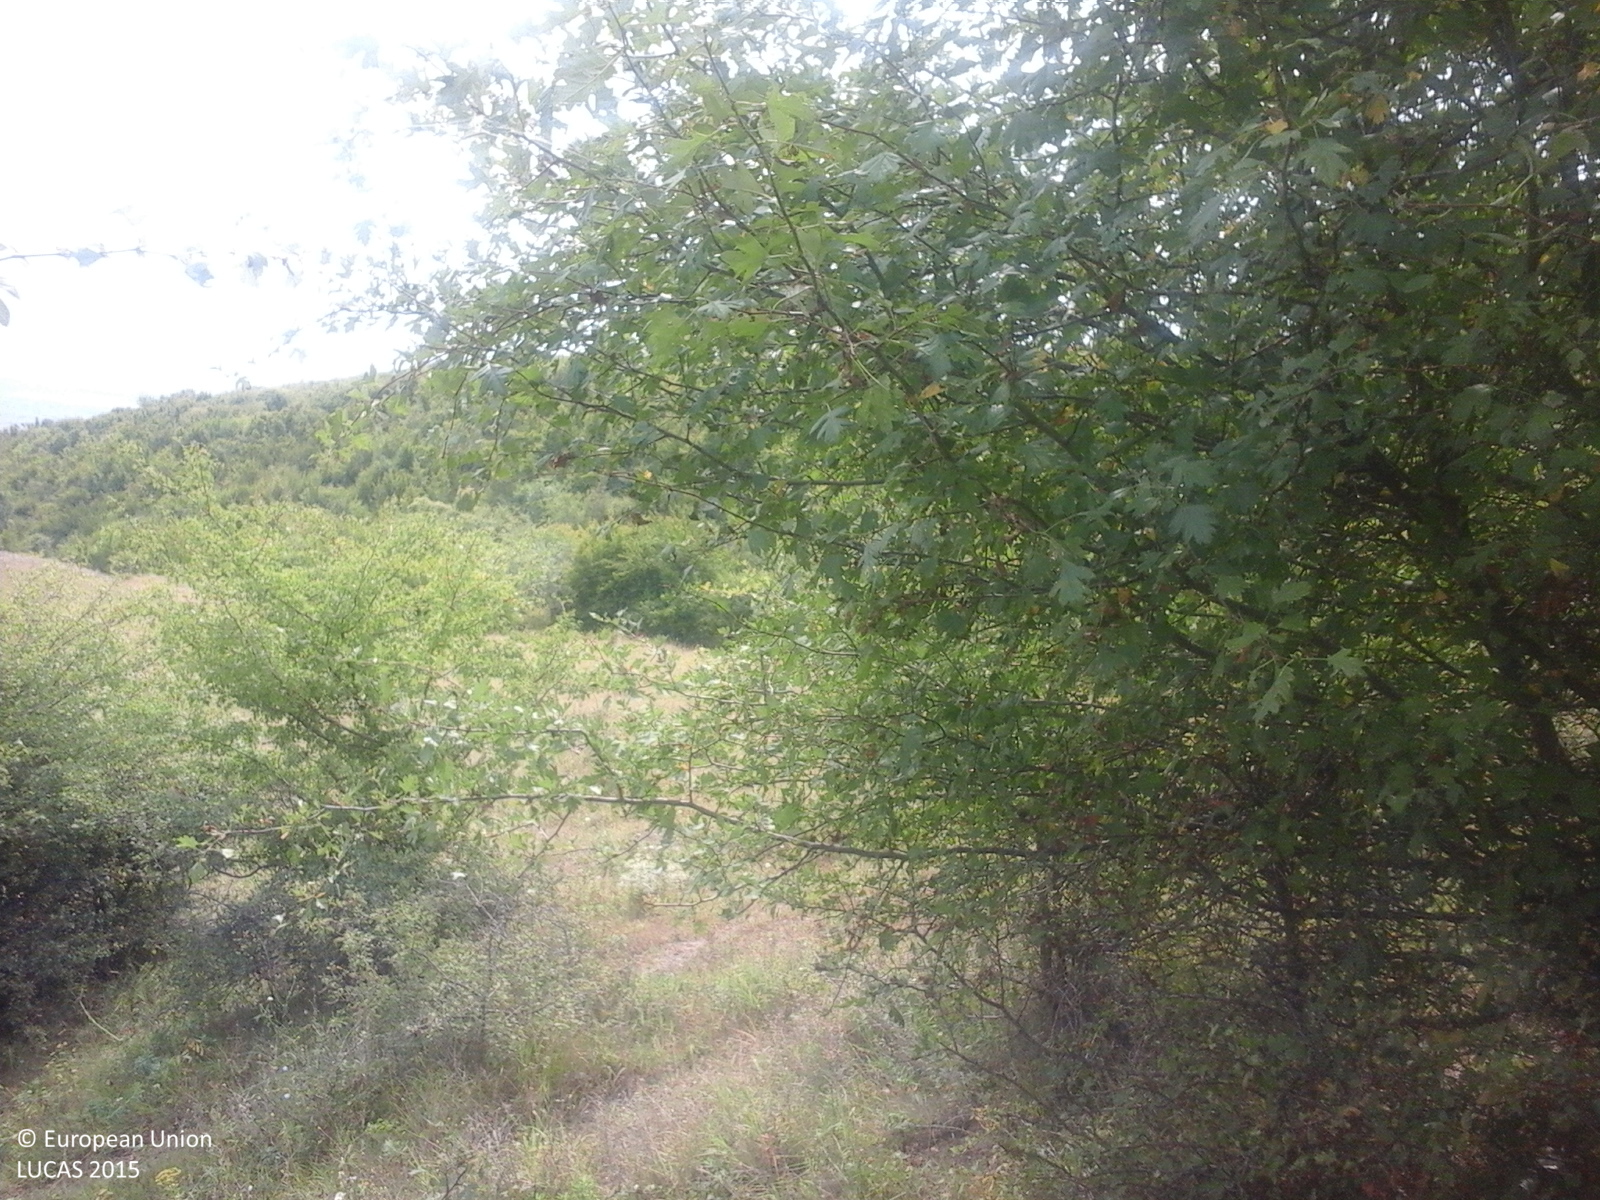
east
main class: Shrubland
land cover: Shrubland with sparse tree cover
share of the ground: > 75 %
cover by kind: herbaceous plants 85 %, shrubs 10 %, broadleaved forest trees 5 %
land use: Fallow land
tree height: > 5 m
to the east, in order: Shrubland with sparse tree cover; Grassland without tree/shrub cover; Grassland with sparse tree/shrub cover; Tracks; Grassland with sparse tree/shrub cover; Ditches and canals; Broadleaved woodland
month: August
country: RO
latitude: 44.0704
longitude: 27.7886
